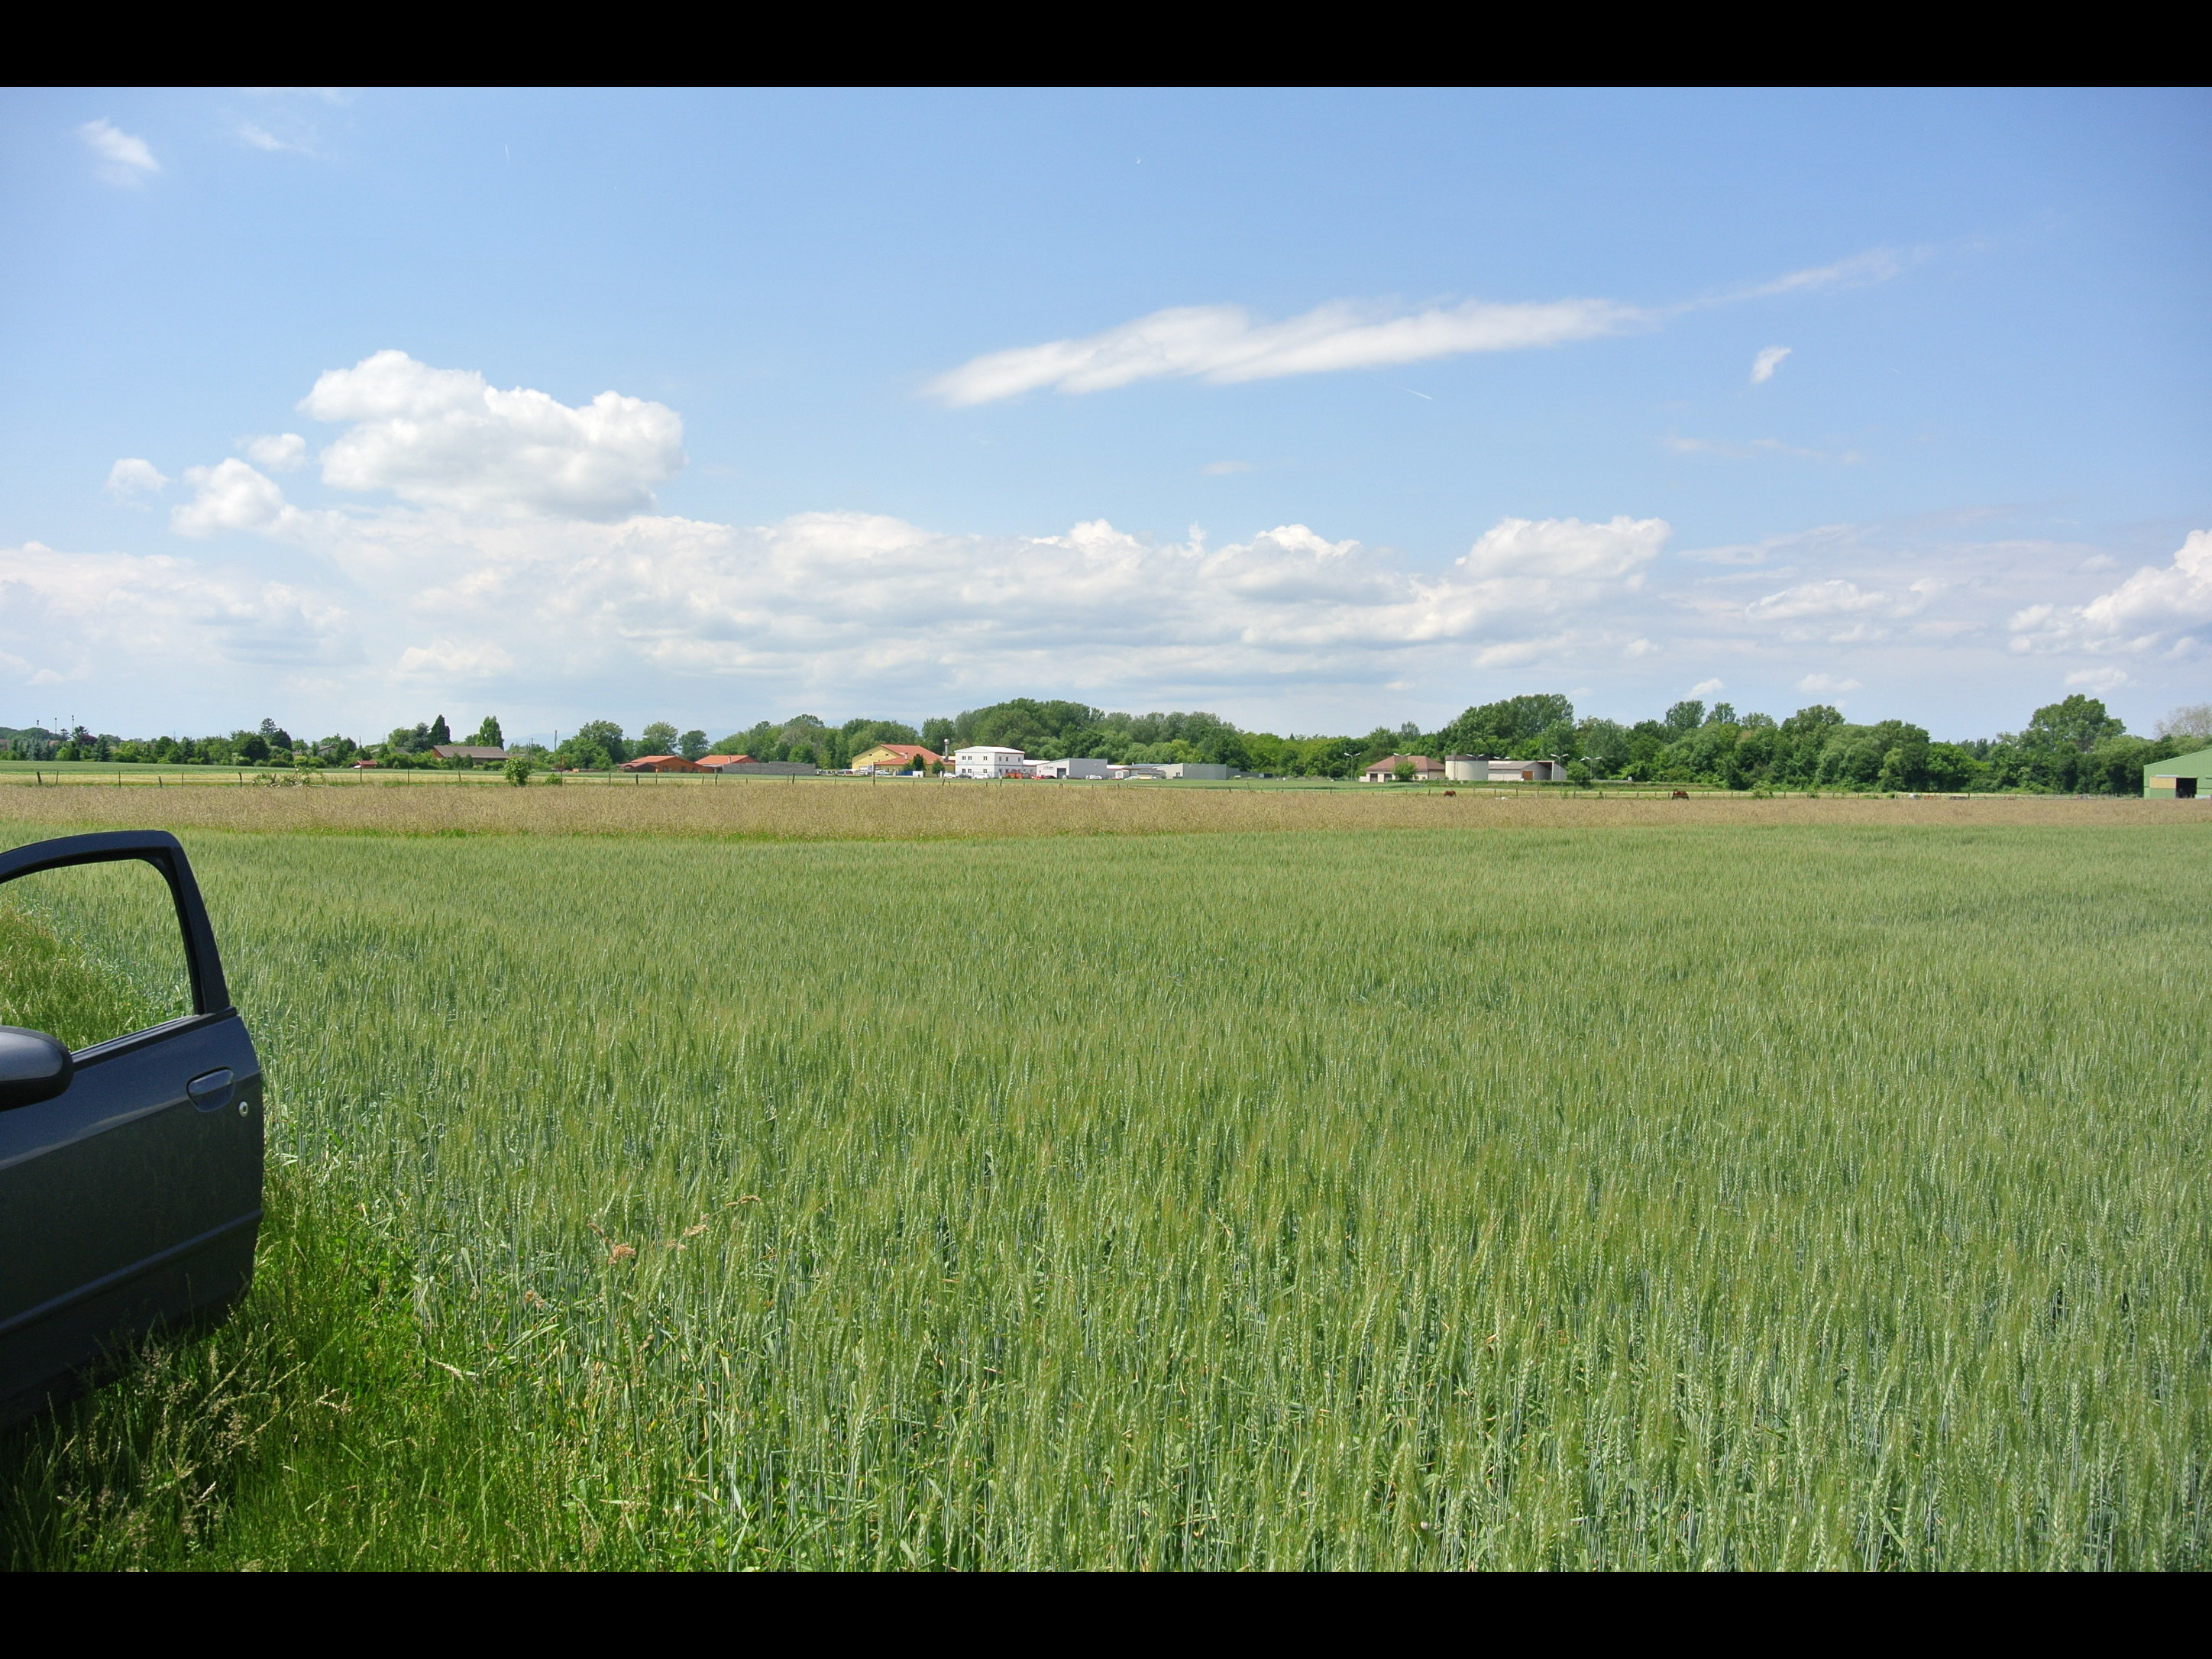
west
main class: Cropland
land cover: Triticale
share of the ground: > 75 %
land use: Agriculture (excluding fallow land and kitchen gardens)
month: June
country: AT
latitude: 47.9268
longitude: 16.4422
